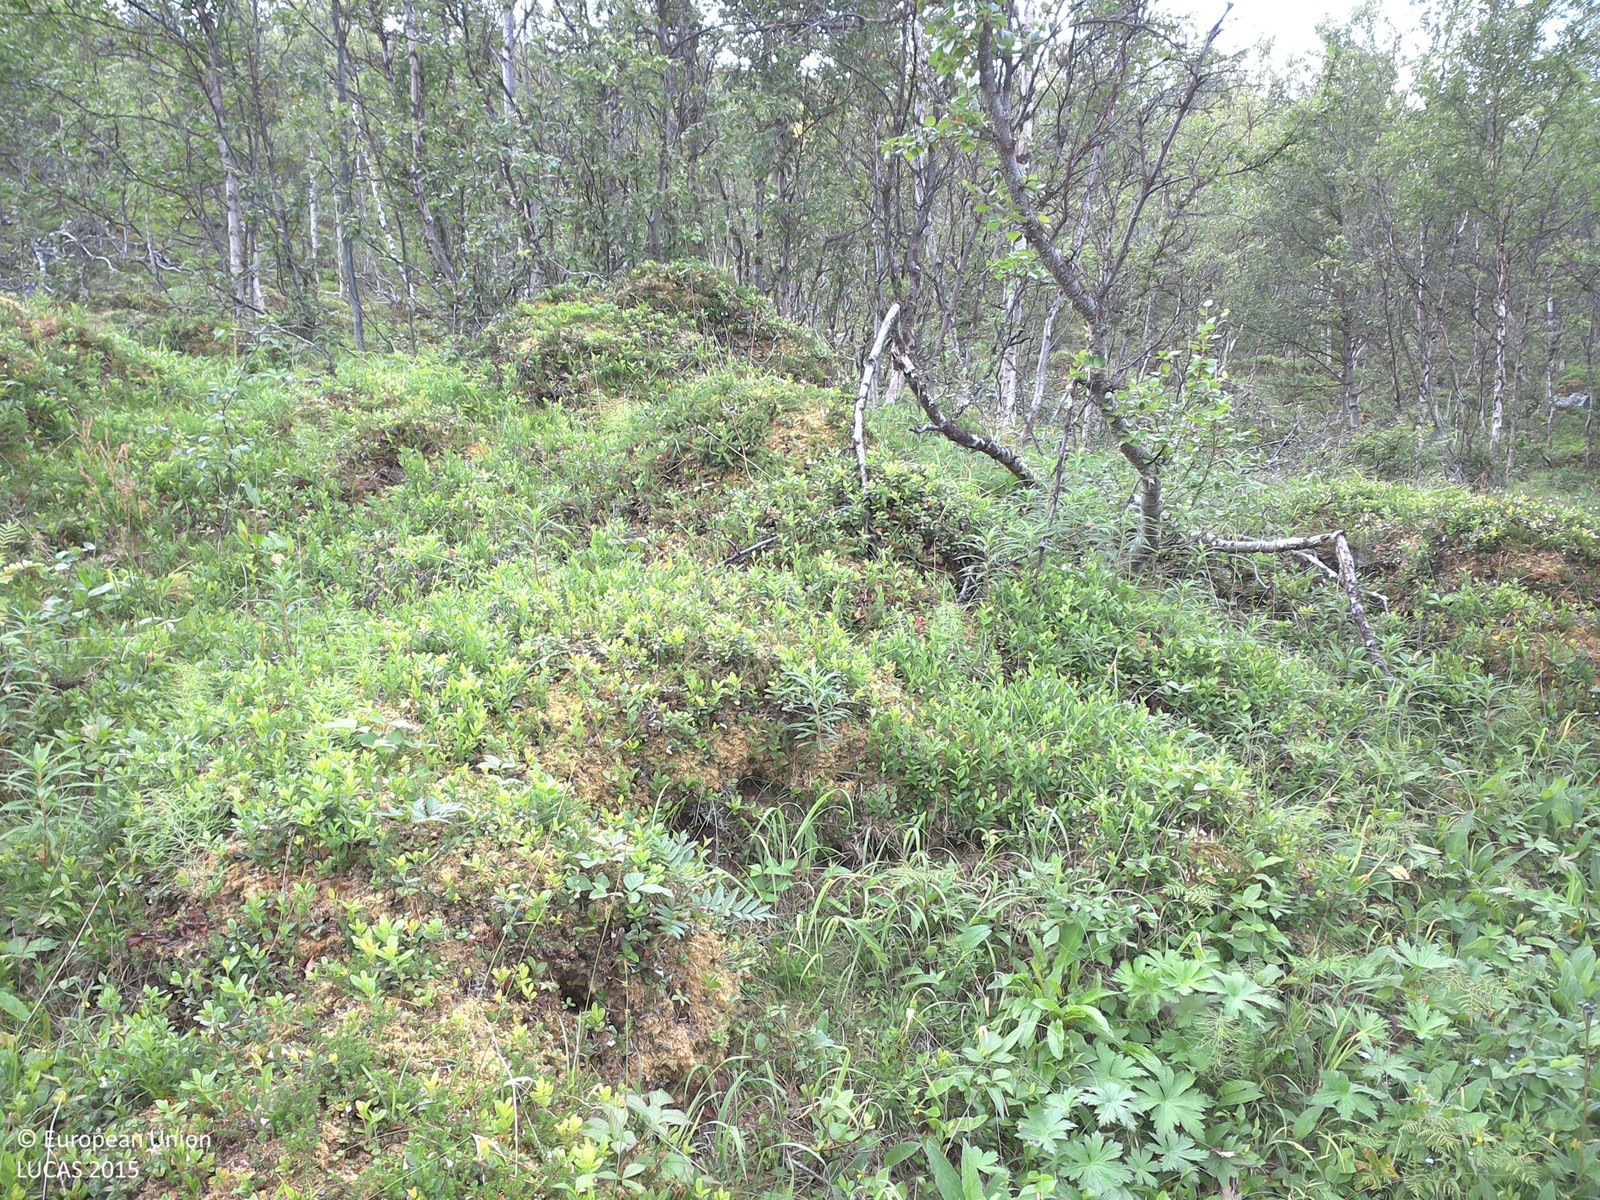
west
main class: Woodland
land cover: Broadleaved woodland
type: boreal forest
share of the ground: 25 - 50 %
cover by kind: shrubs 50 %, broadleaved forest trees 25 %, herbaceous plants 20 %, lichens and mosses 5 %
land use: Amenities, museums, leisure
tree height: > 5 m
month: August
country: SE
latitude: 68.3664
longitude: 18.7549
